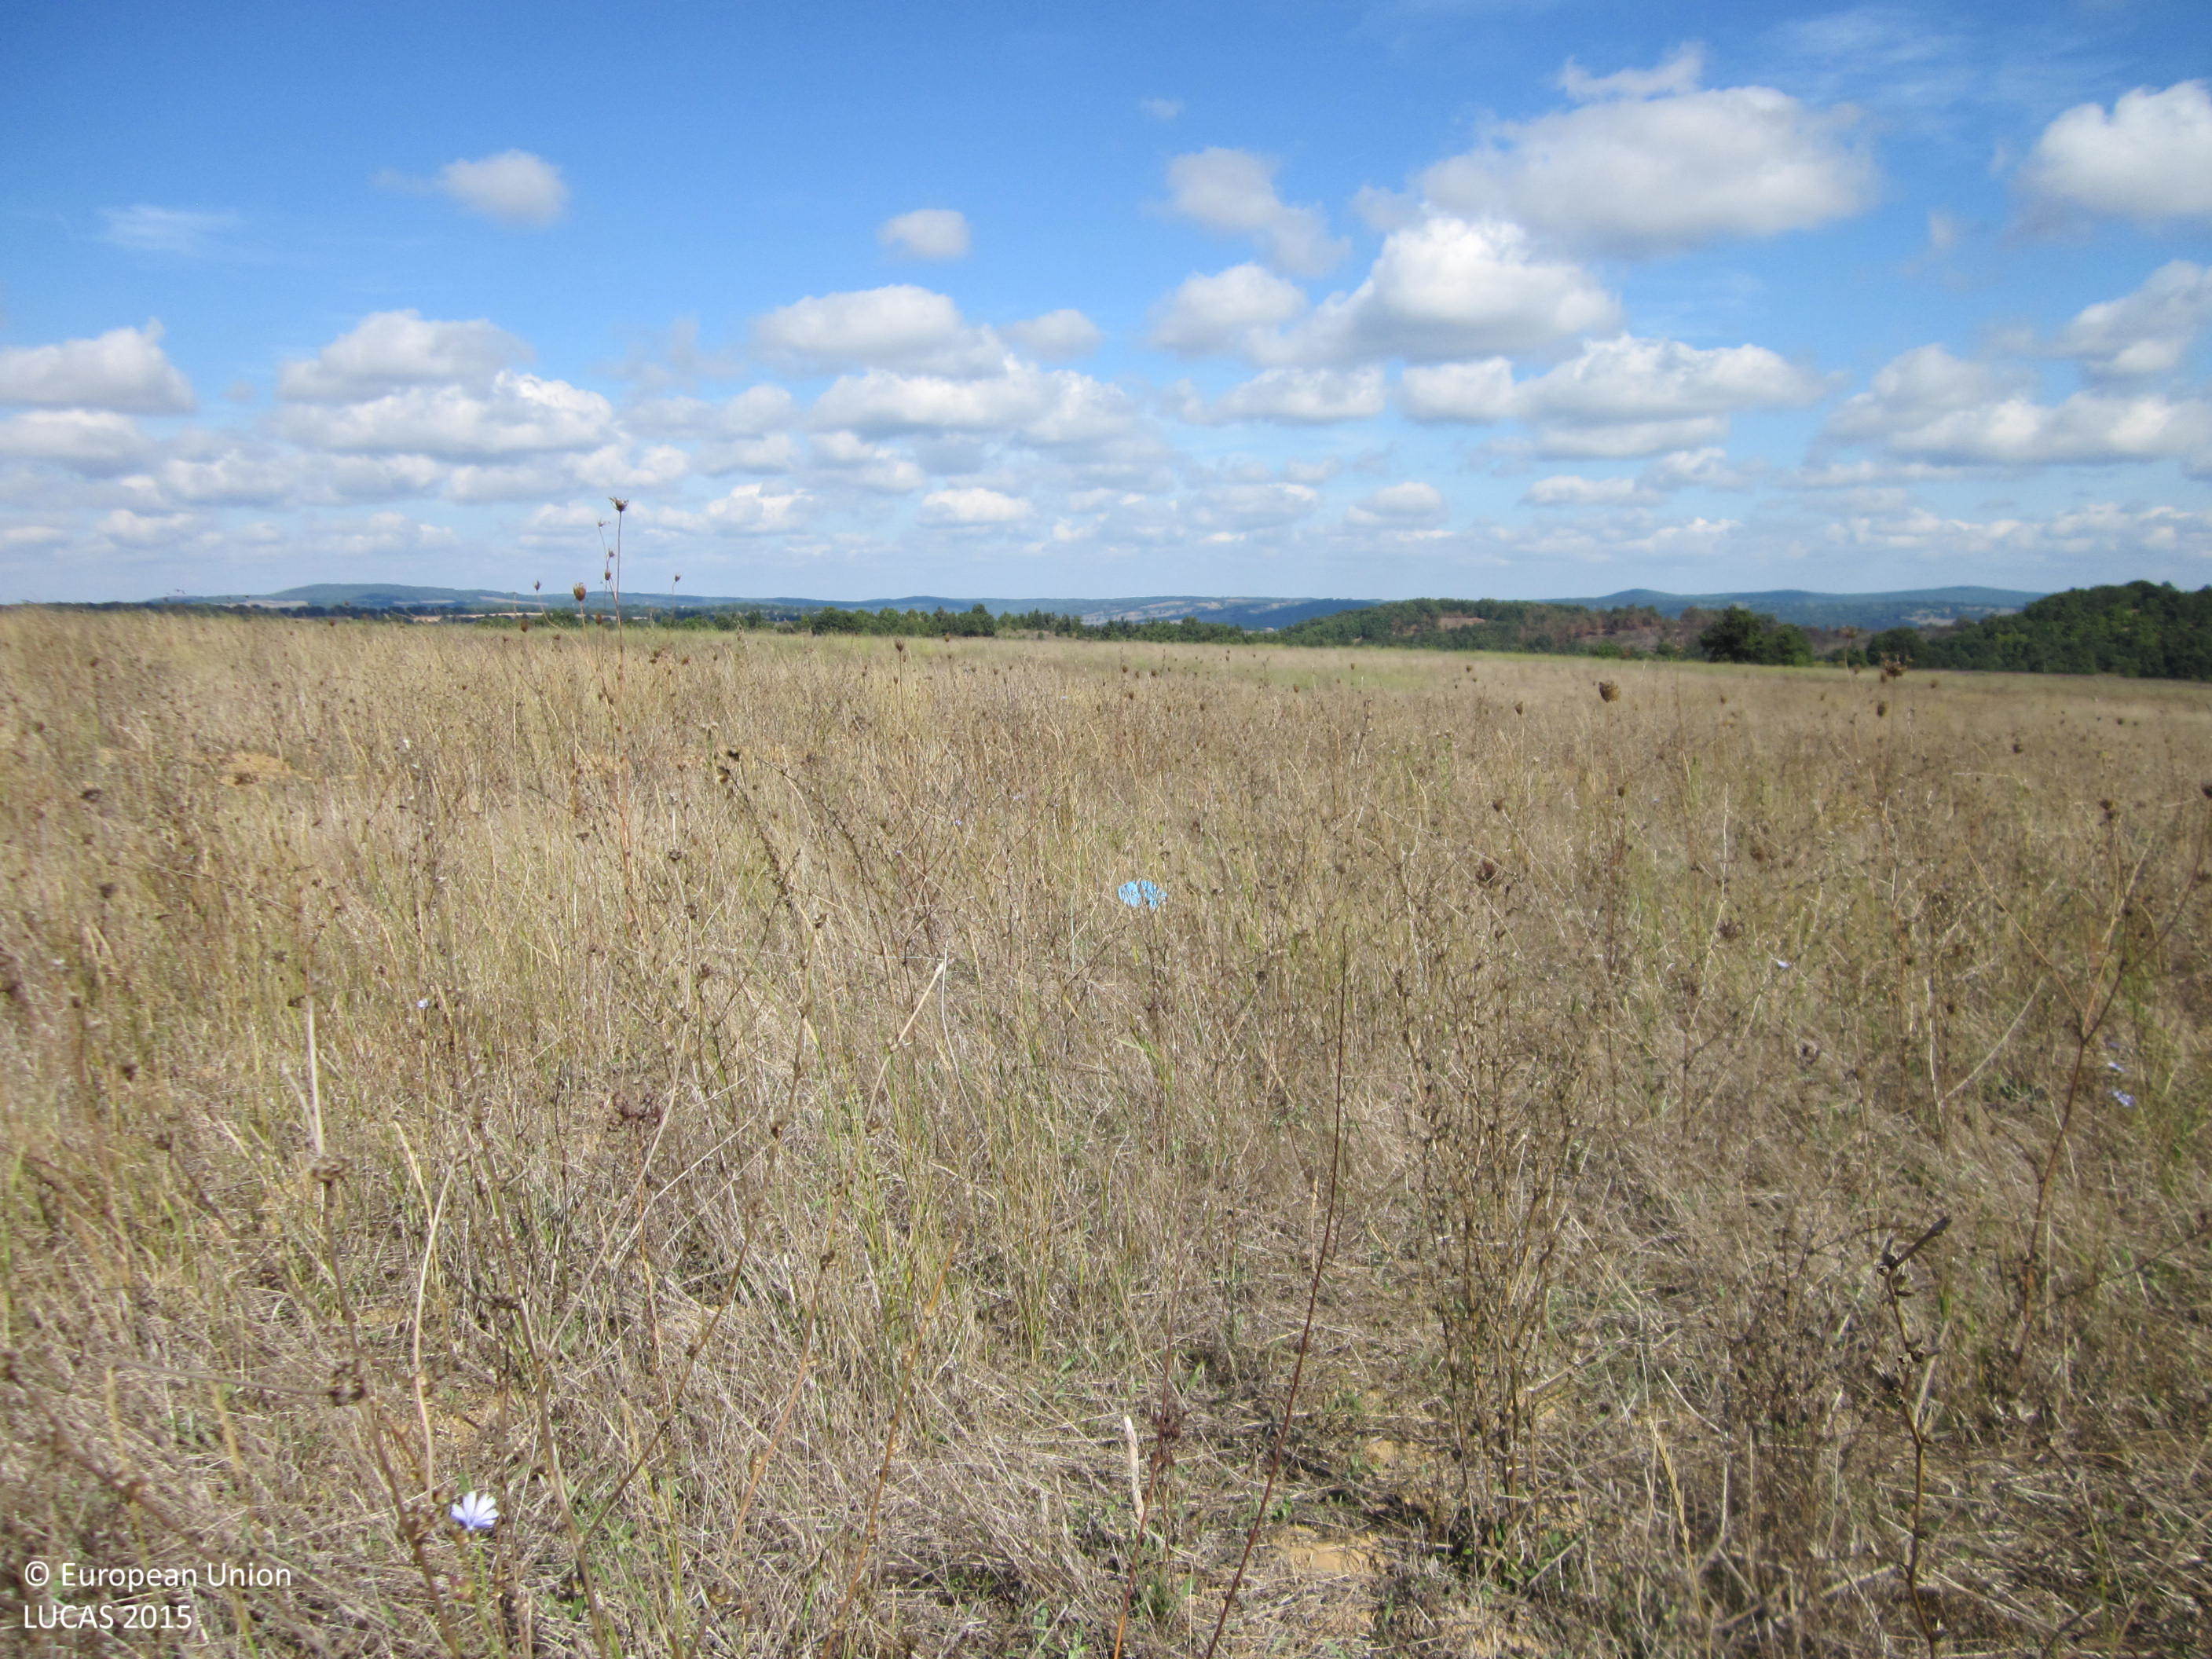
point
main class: Grassland
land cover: Spontaneously vegetated surfaces
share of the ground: > 75 %
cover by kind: herbaceous plants 95 %, unconsolidated bare surface 5 %
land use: Fallow land
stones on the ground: < 10 %
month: September
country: BG
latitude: 42.1444
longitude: 27.1032
